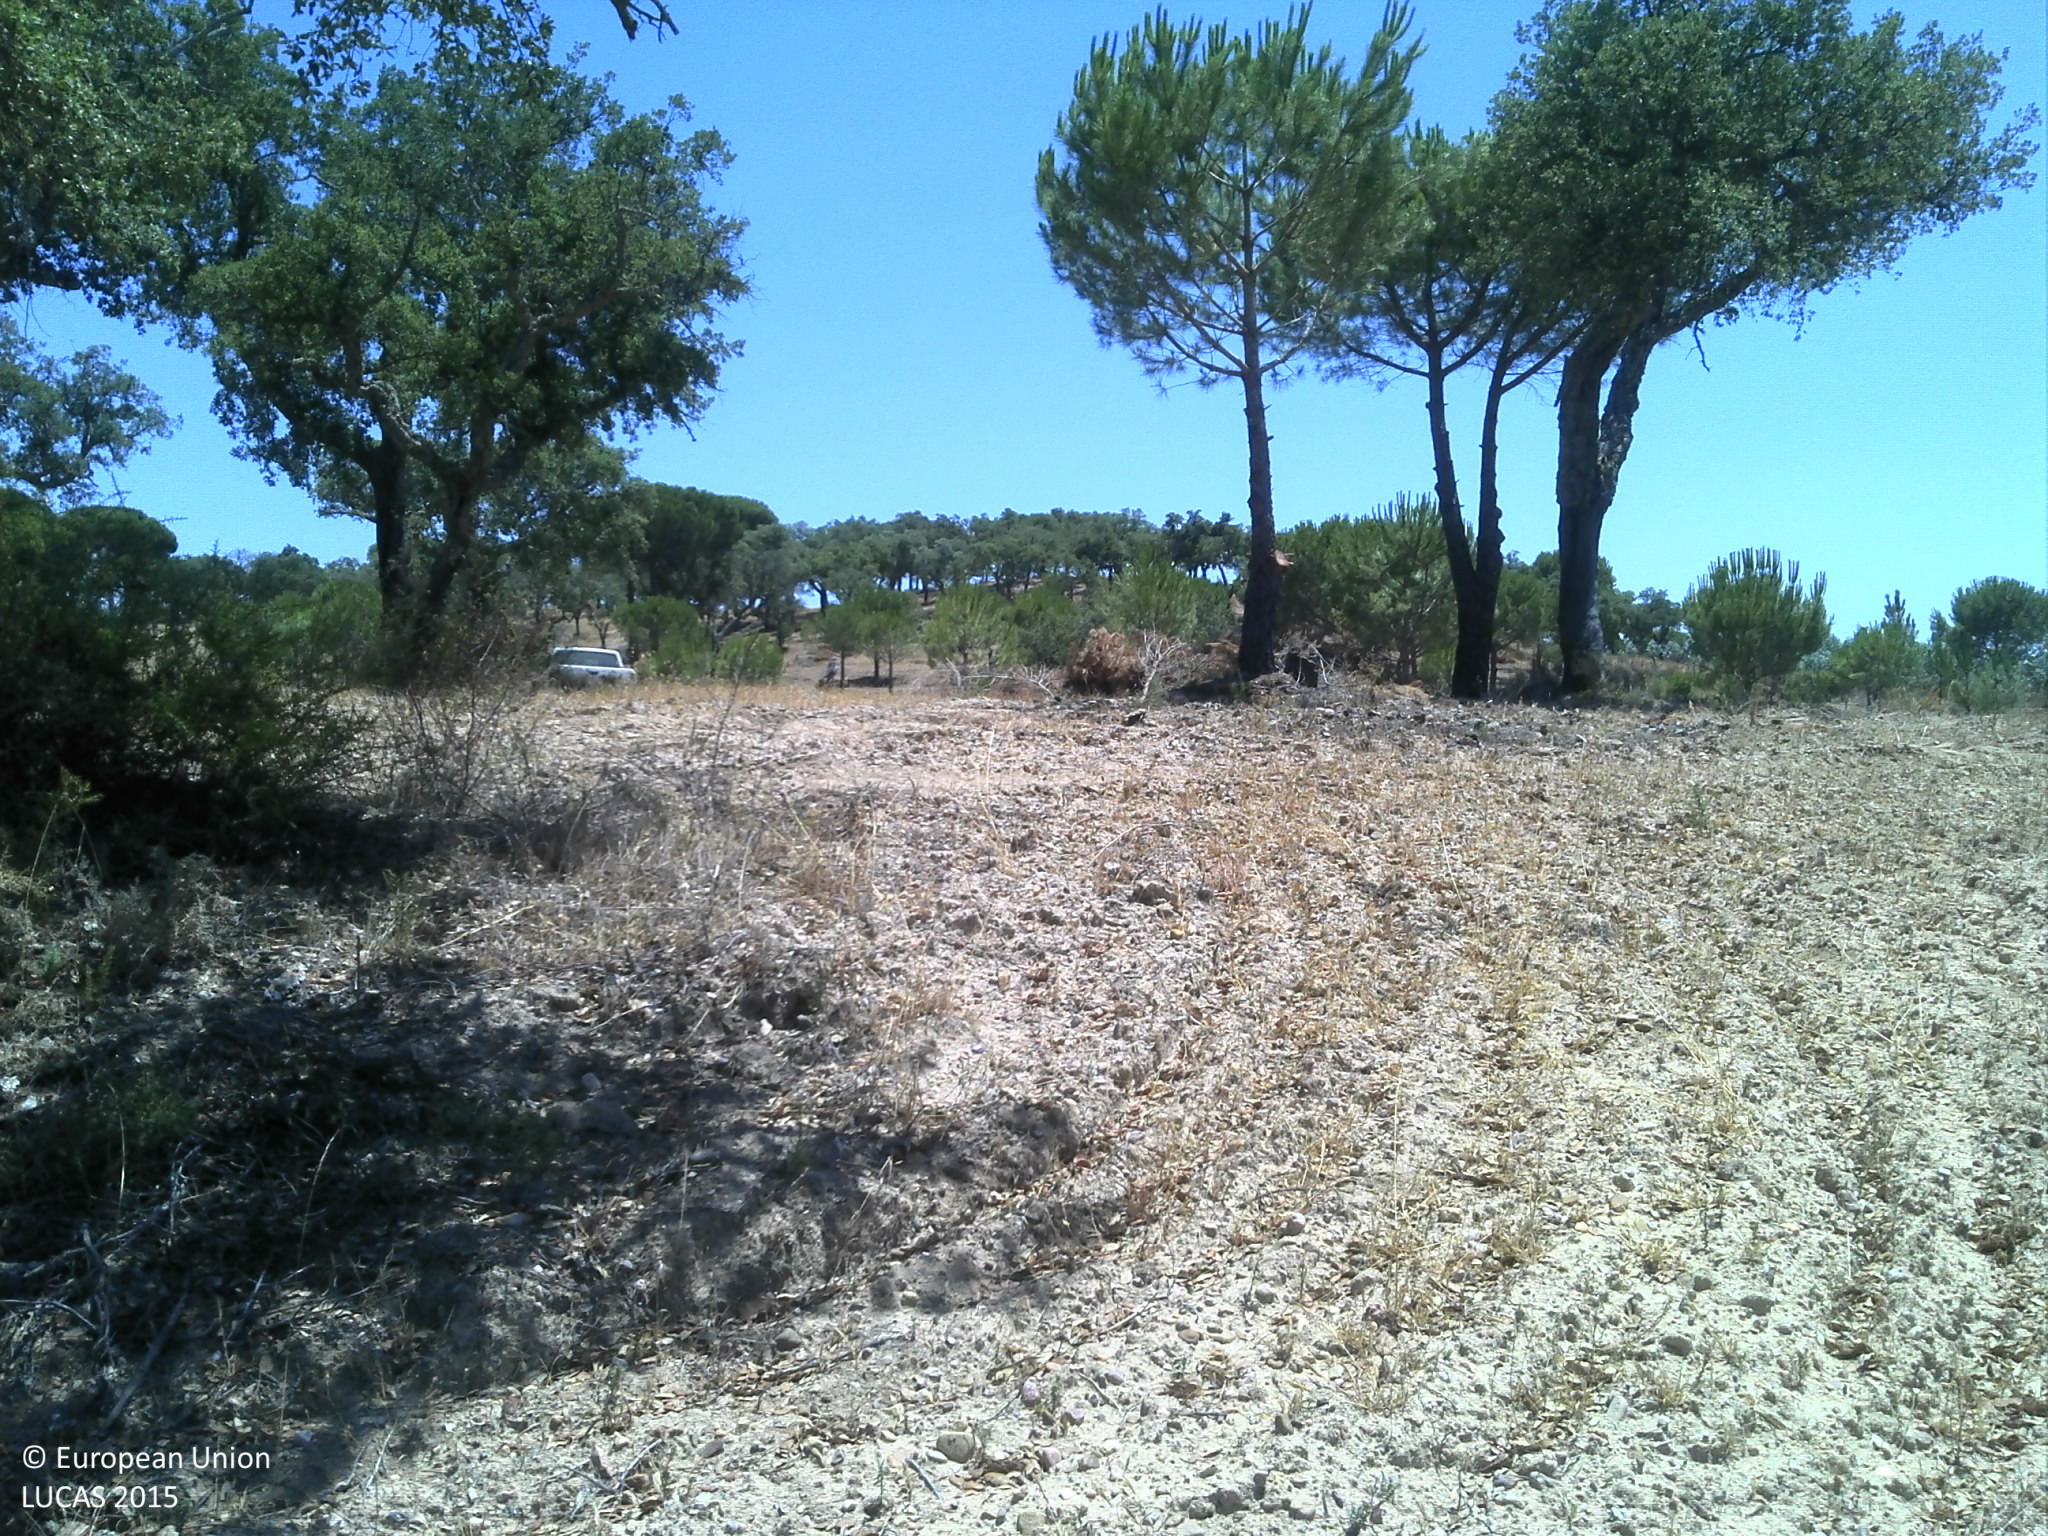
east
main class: Woodland
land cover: Broadleaved woodland
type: broadleaved evergreen forest
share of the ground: 25 - 50 %
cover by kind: unconsolidated bare surface 55 %, broadleaved forest trees 35 %, herbaceous plants 10 %
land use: Forestry
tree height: > 5 m
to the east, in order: Broadleaved woodland; Pine dominated coniferous woodland; Broadleaved woodland
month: July
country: PT
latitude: 39.0511
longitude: -8.2803
